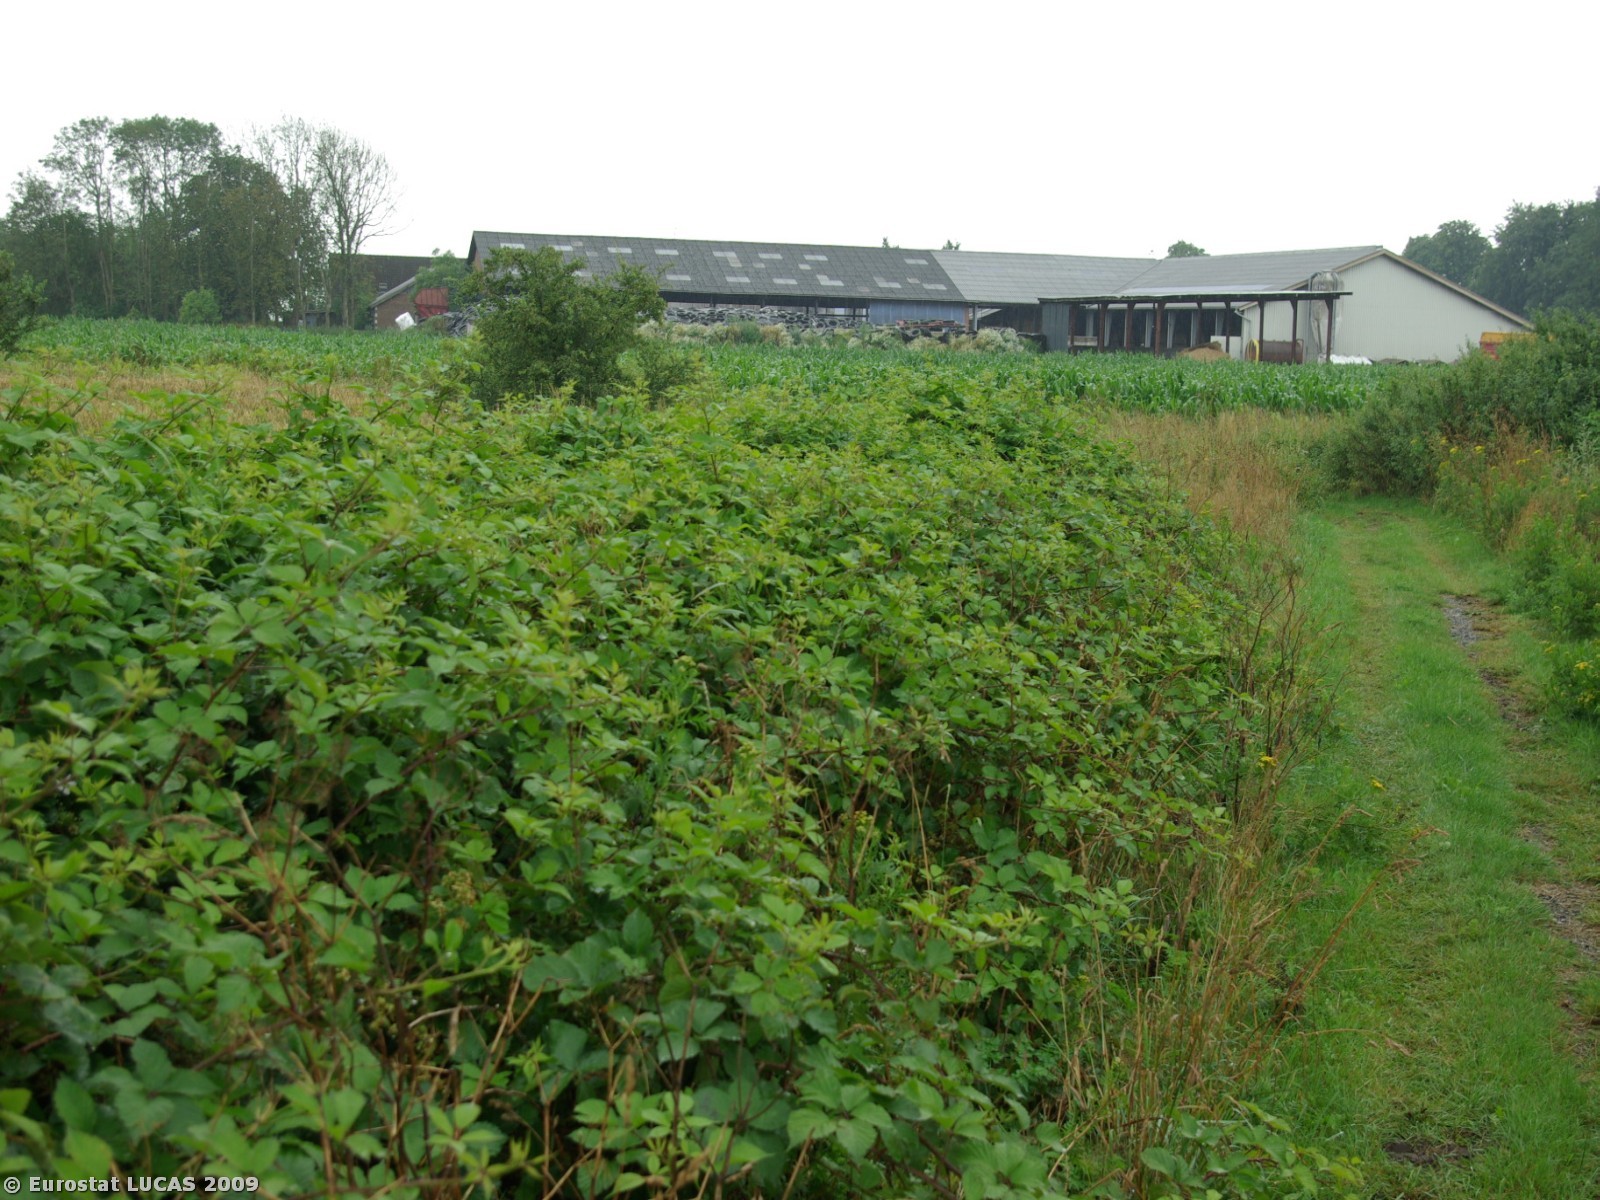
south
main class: Cropland
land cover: Maize
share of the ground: > 75 %
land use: Agriculture (excluding fallow land and kitchen gardens)
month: July
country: DK
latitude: 55.2476
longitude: 8.8212
